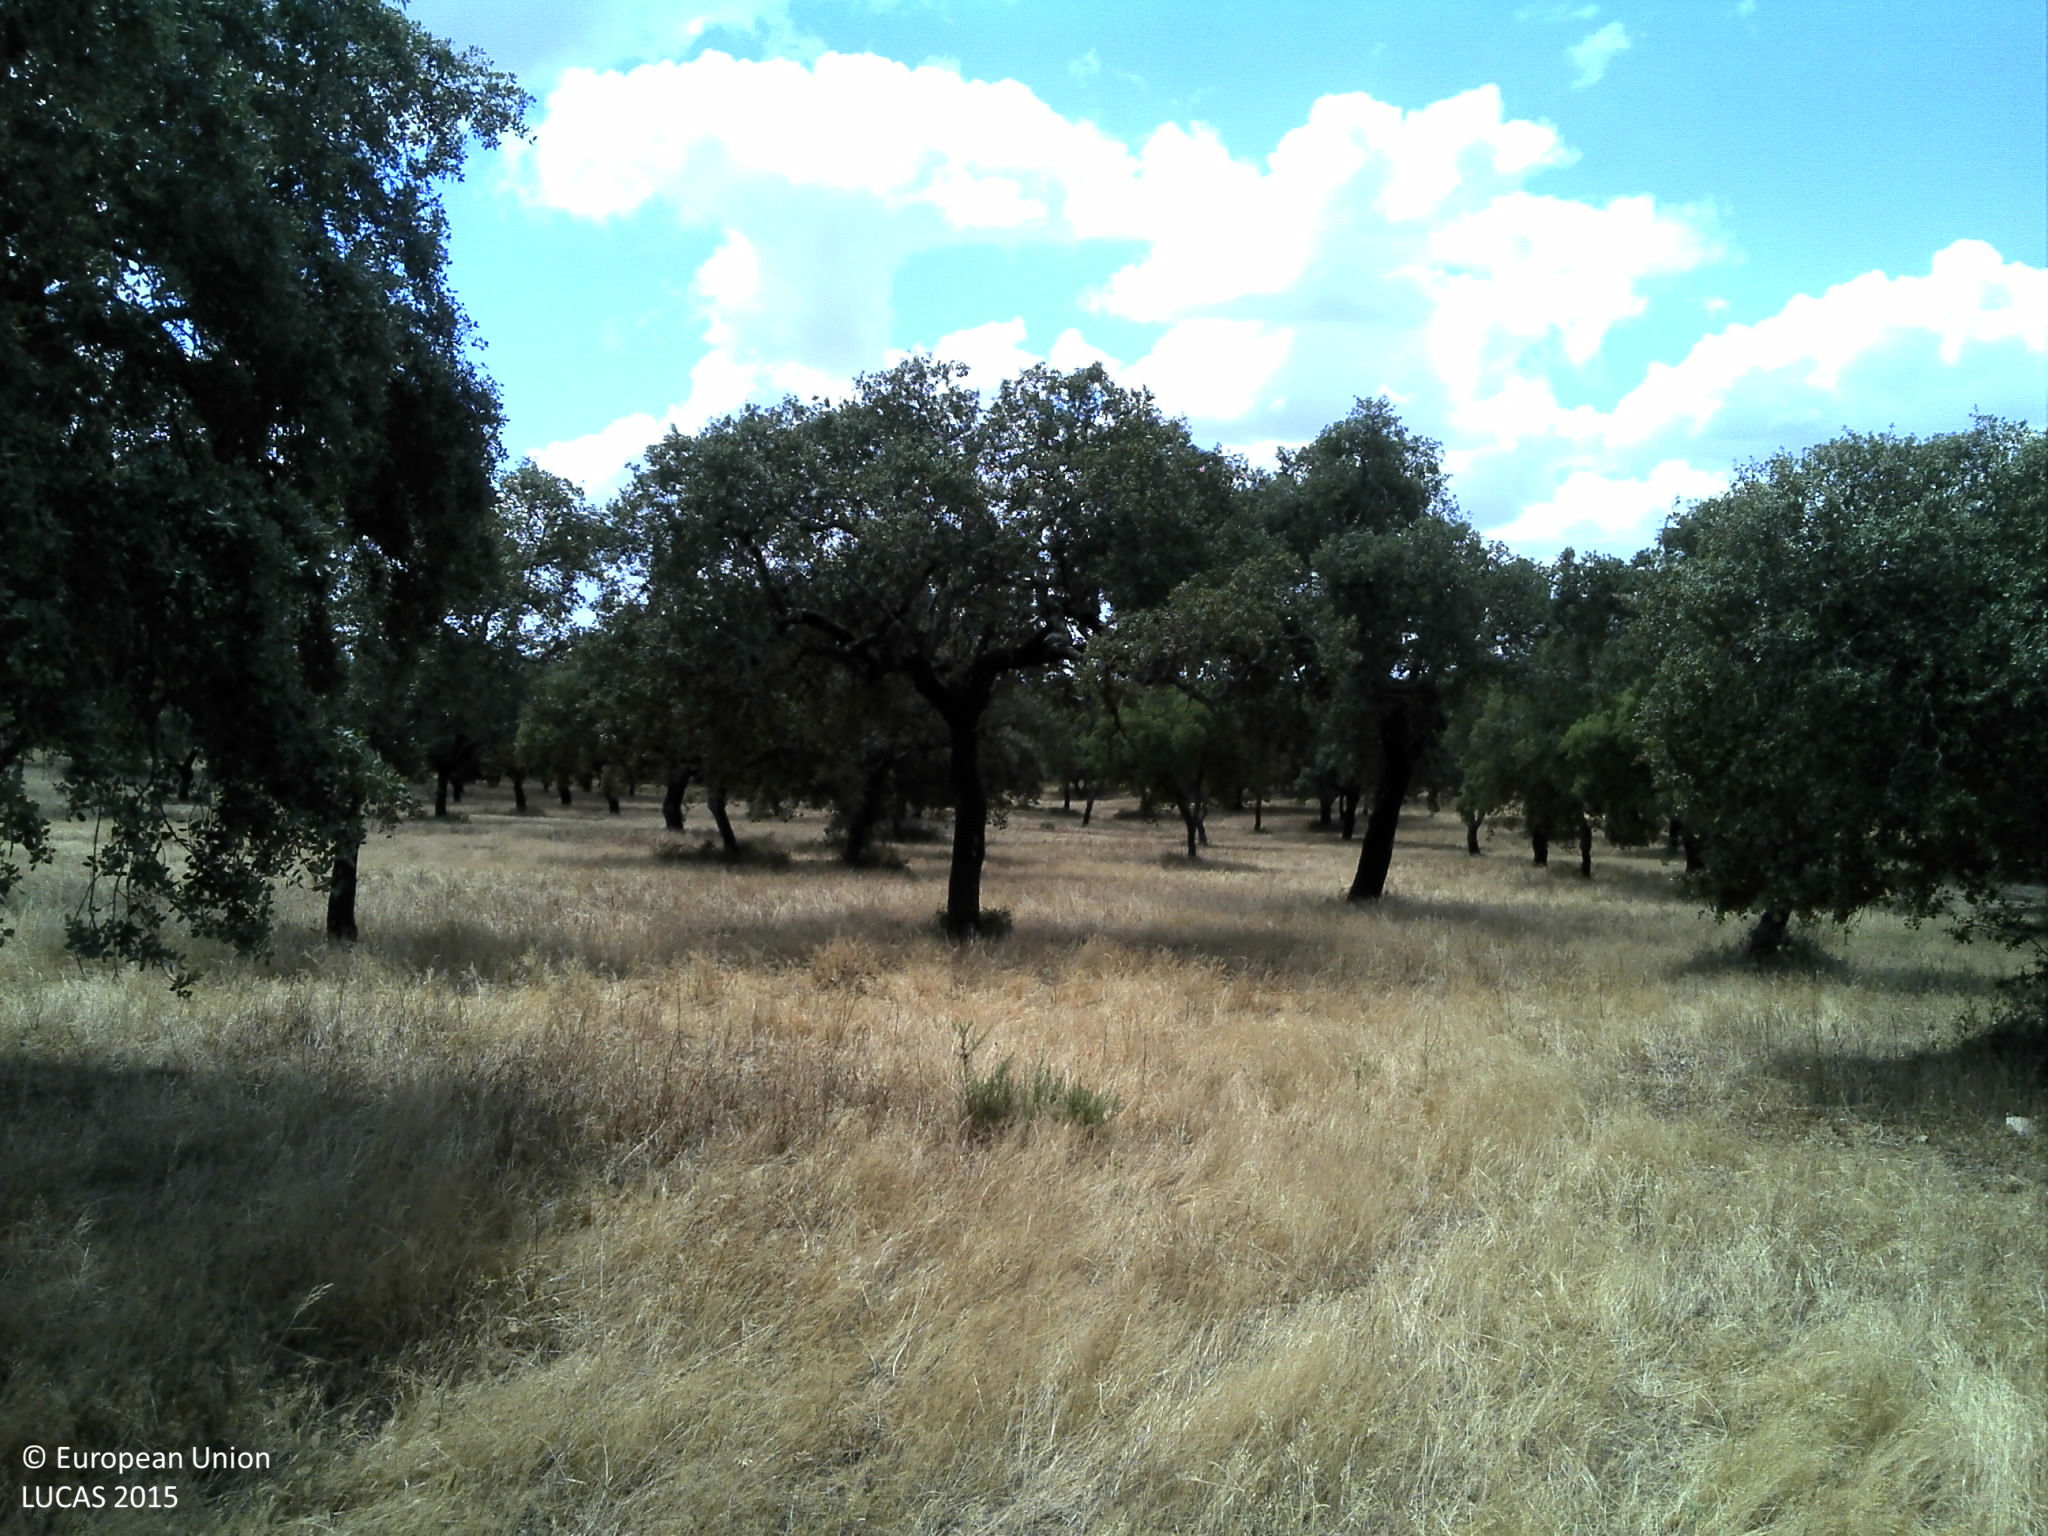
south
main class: Woodland
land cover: Broadleaved woodland
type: broadleaved evergreen forest
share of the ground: 25 - 50 %
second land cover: Grassland without tree/shrub cover
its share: 10 - 25 %
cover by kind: unconsolidated bare surface 55 %, broadleaved forest trees 30 %, herbaceous plants 15 %
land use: Forestry
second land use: Agriculture (excluding fallow land and kitchen gardens)
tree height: > 5 m
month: June
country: PT
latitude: 38.4980
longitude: -8.0784
